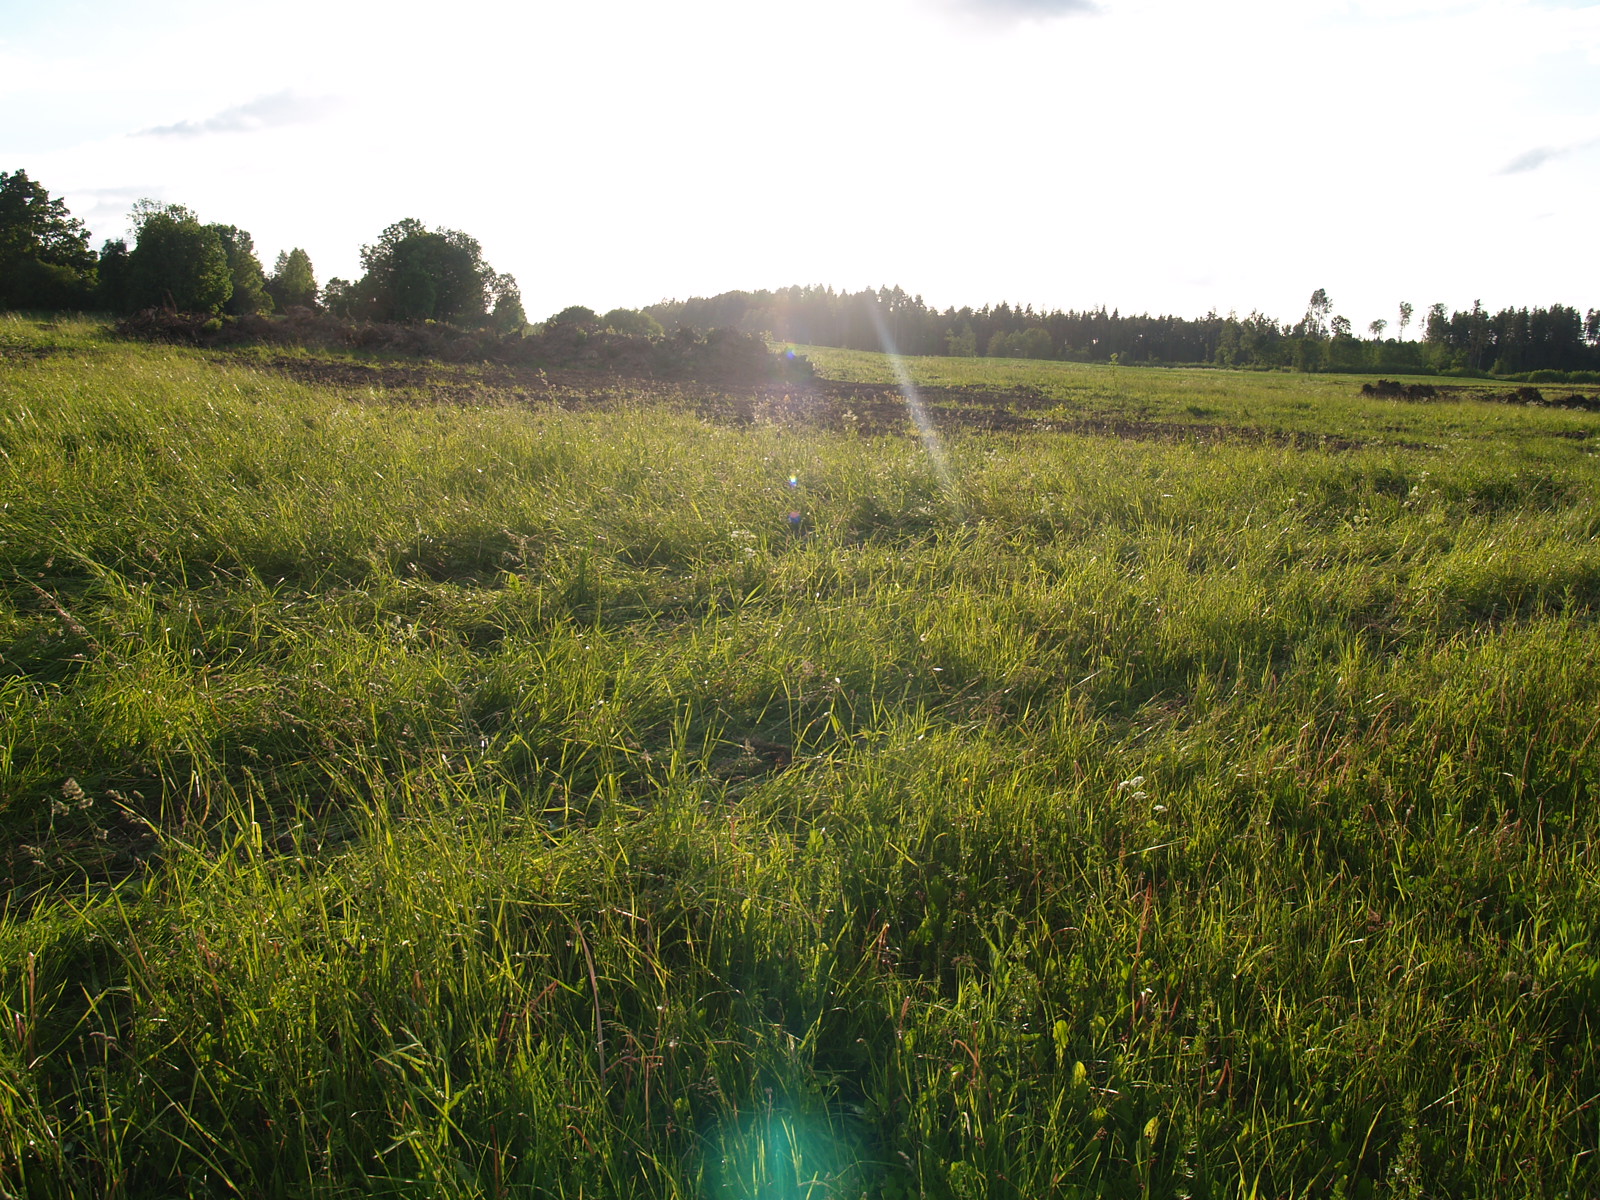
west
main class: Grassland
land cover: Grassland without tree/shrub cover
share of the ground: > 75 %
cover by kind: herbaceous plants 100 %
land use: Agriculture (excluding fallow land and kitchen gardens)
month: June
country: LV
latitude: 56.6488
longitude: 25.6666
